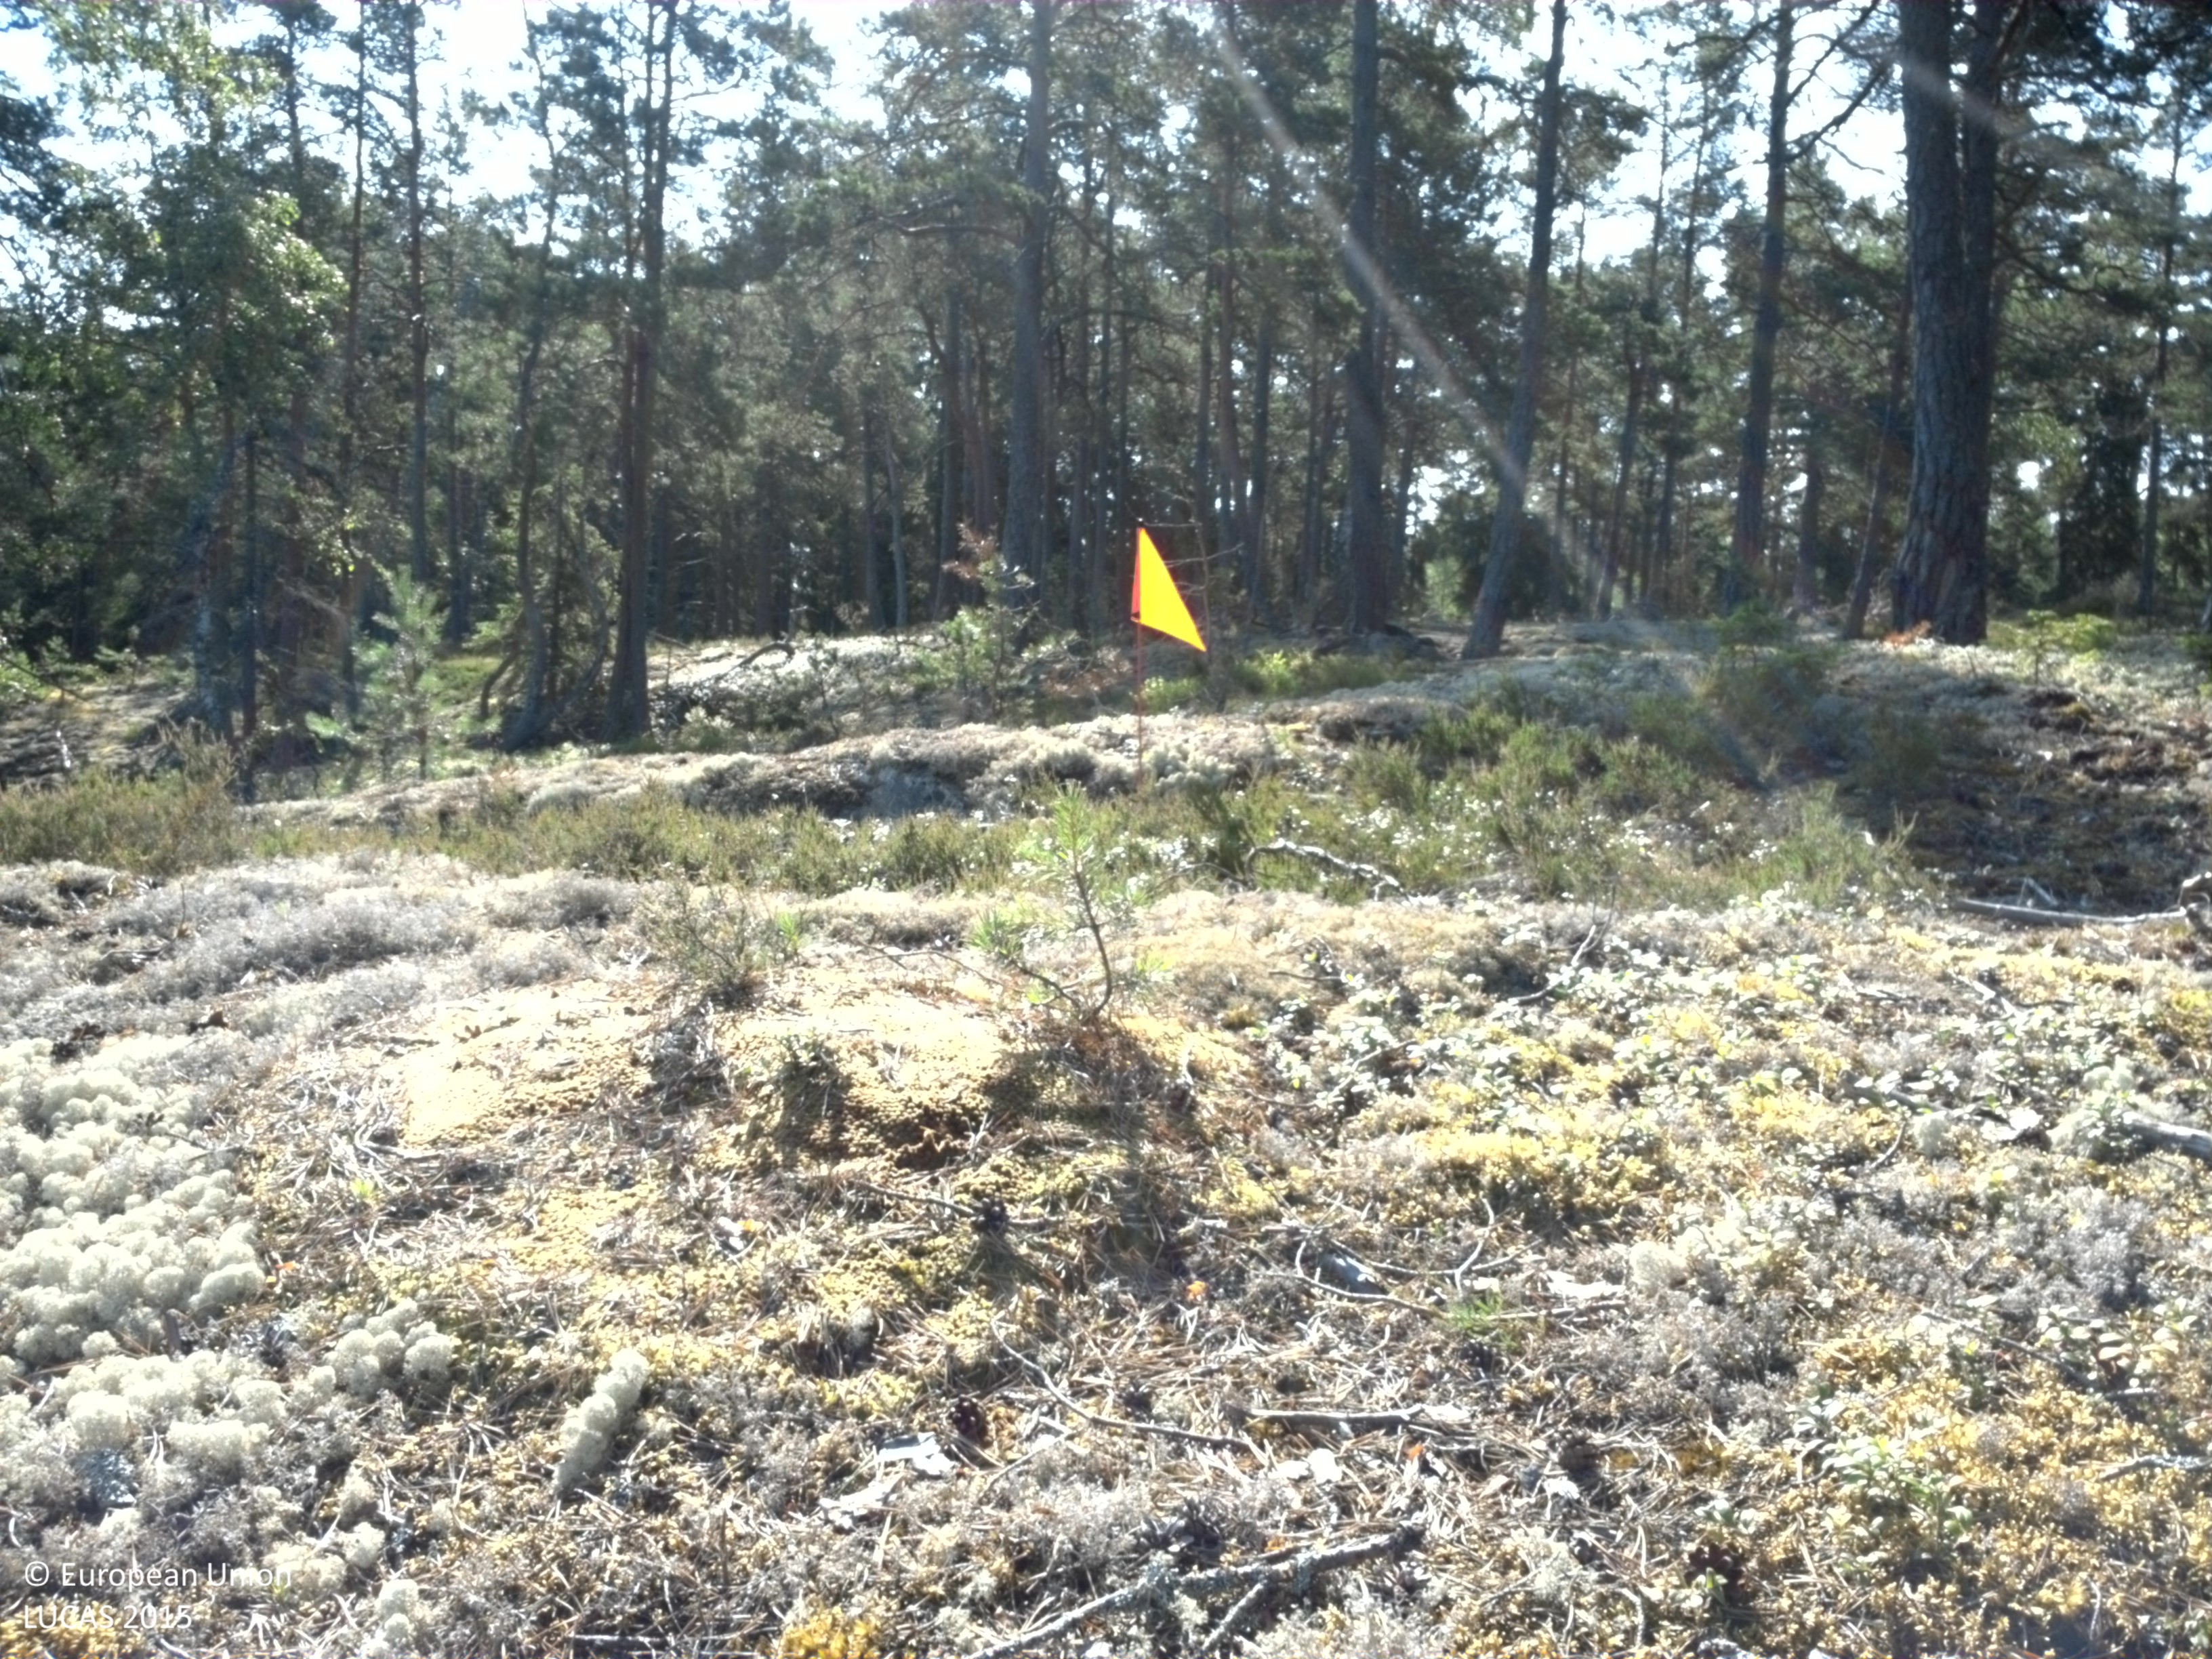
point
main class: Woodland
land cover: Pine dominated coniferous woodland
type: boreal forest
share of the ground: 25 - 50 %
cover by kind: coniferous forest trees 50 %, lichens and mosses 20 %, consolidated bare surface 20 %, shrubs 10 %
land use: Forestry
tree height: > 5 m
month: July
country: SE
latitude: 59.7058
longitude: 18.5123
